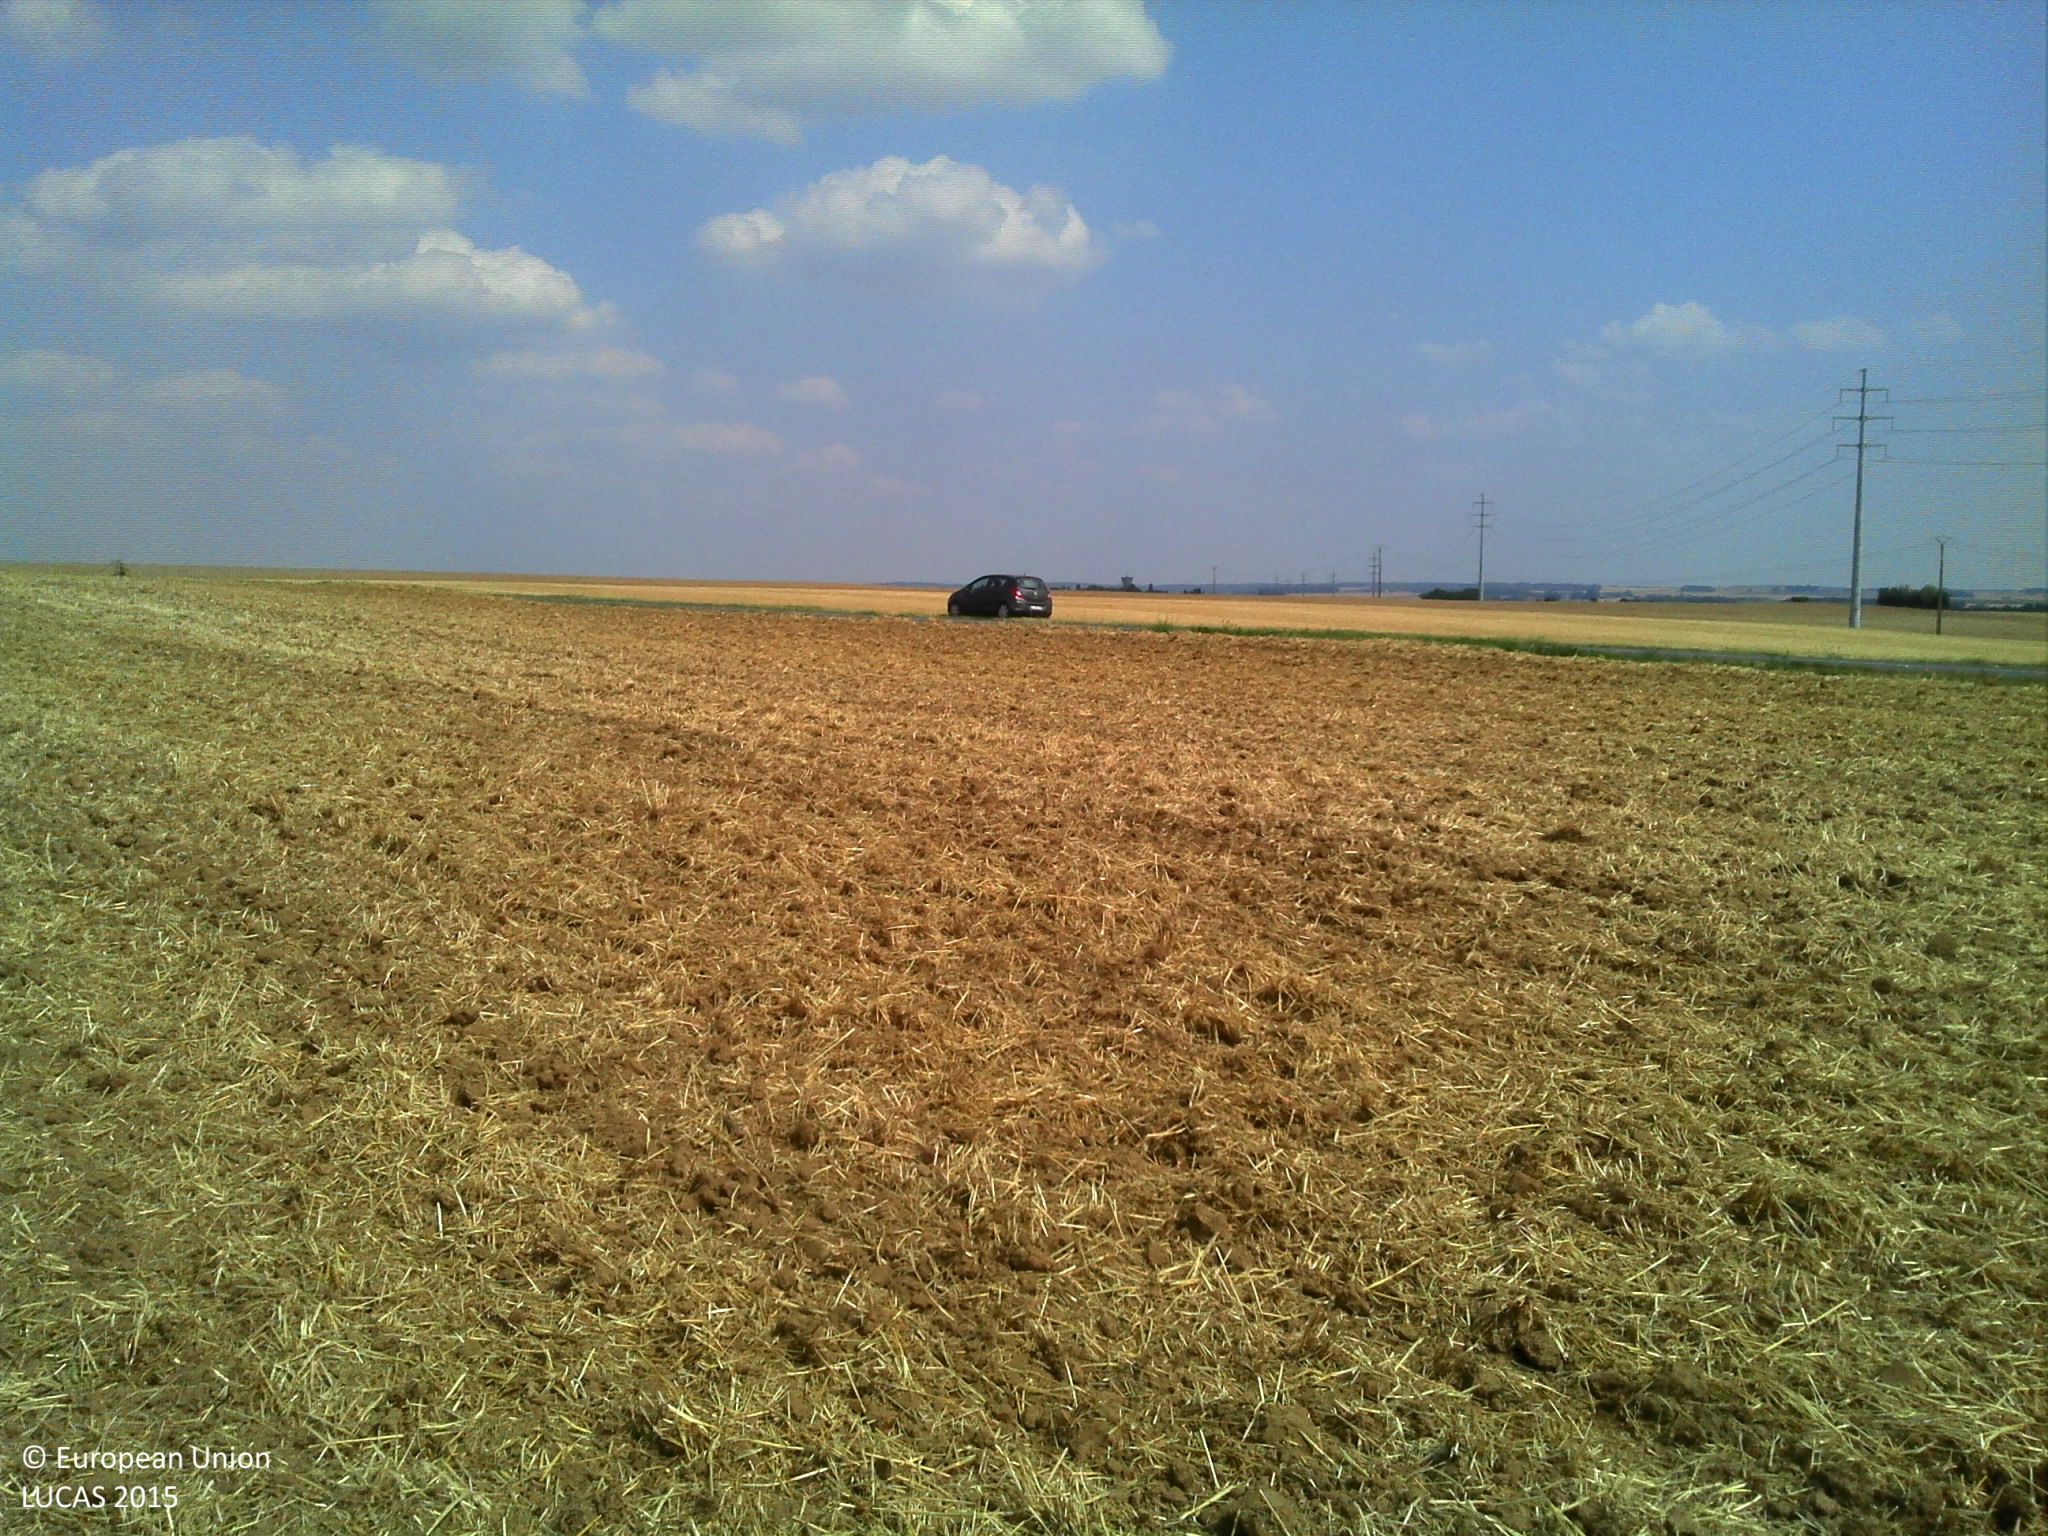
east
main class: Cropland
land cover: Common wheat
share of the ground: > 75 %
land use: Agriculture (excluding fallow land and kitchen gardens)
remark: Harvested field
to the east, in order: Common wheat; Ditches and canals; Grass margins; Paved roads, cycling and walking lanes; Grass margins; Common wheat
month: August
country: FR
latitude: 49.0287
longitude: 2.9748
